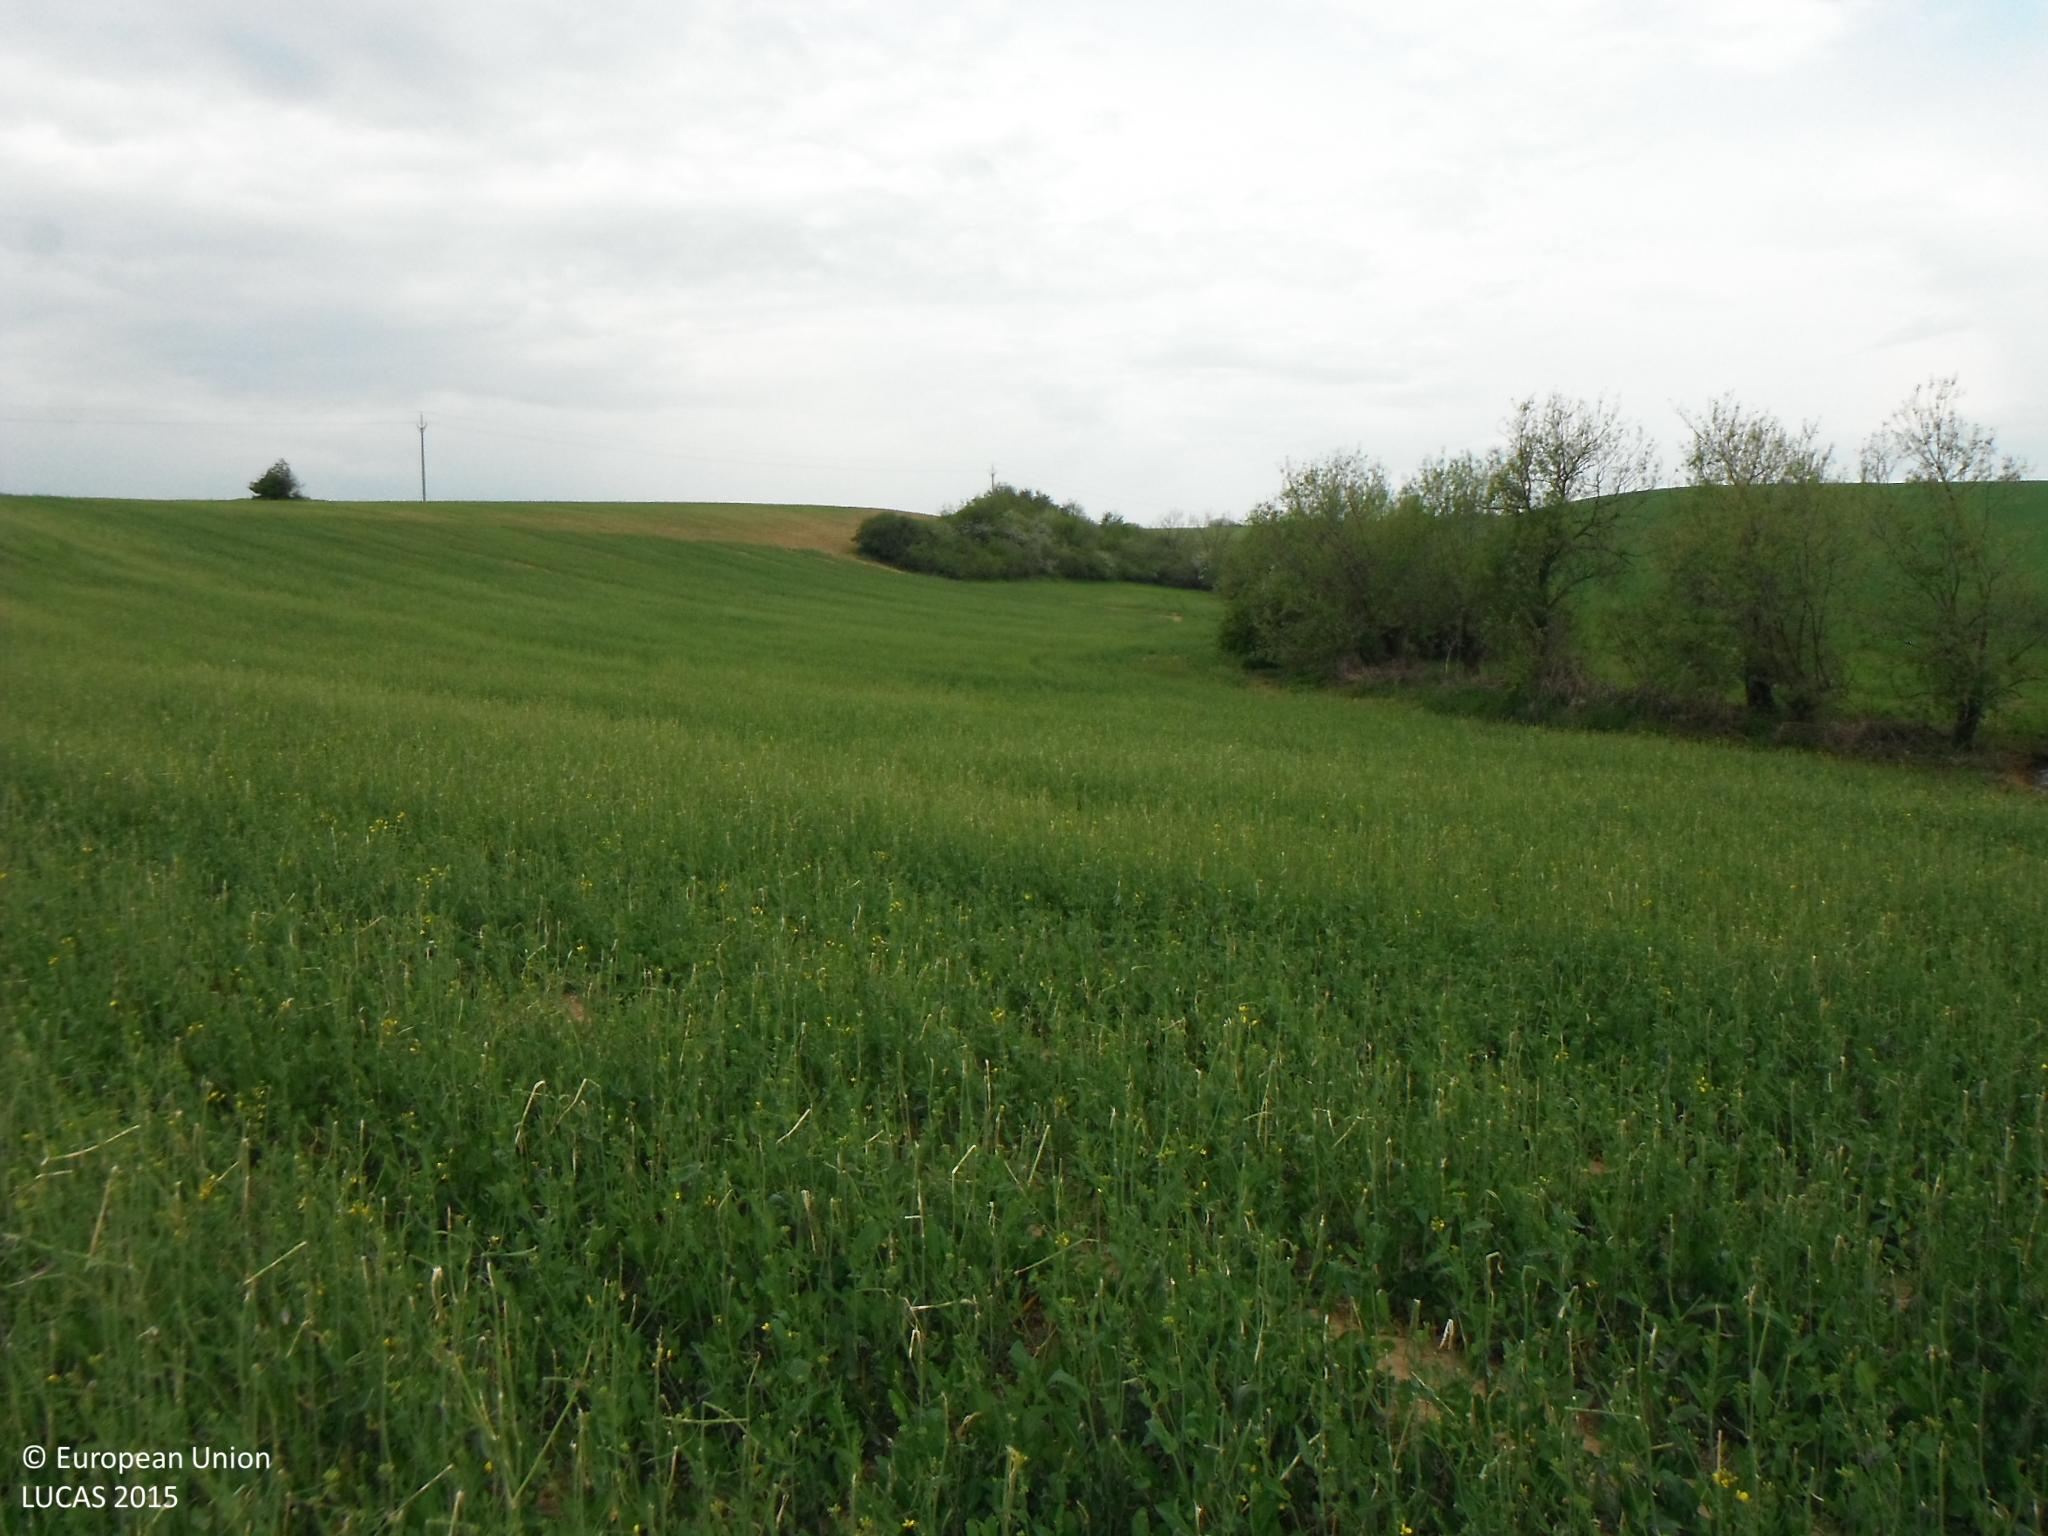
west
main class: Cropland
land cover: Rape and turnip rape
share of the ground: > 75 %
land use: Agriculture (excluding fallow land and kitchen gardens)
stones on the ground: < 10 %
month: May
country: SK
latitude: 49.0320
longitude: 21.1917
